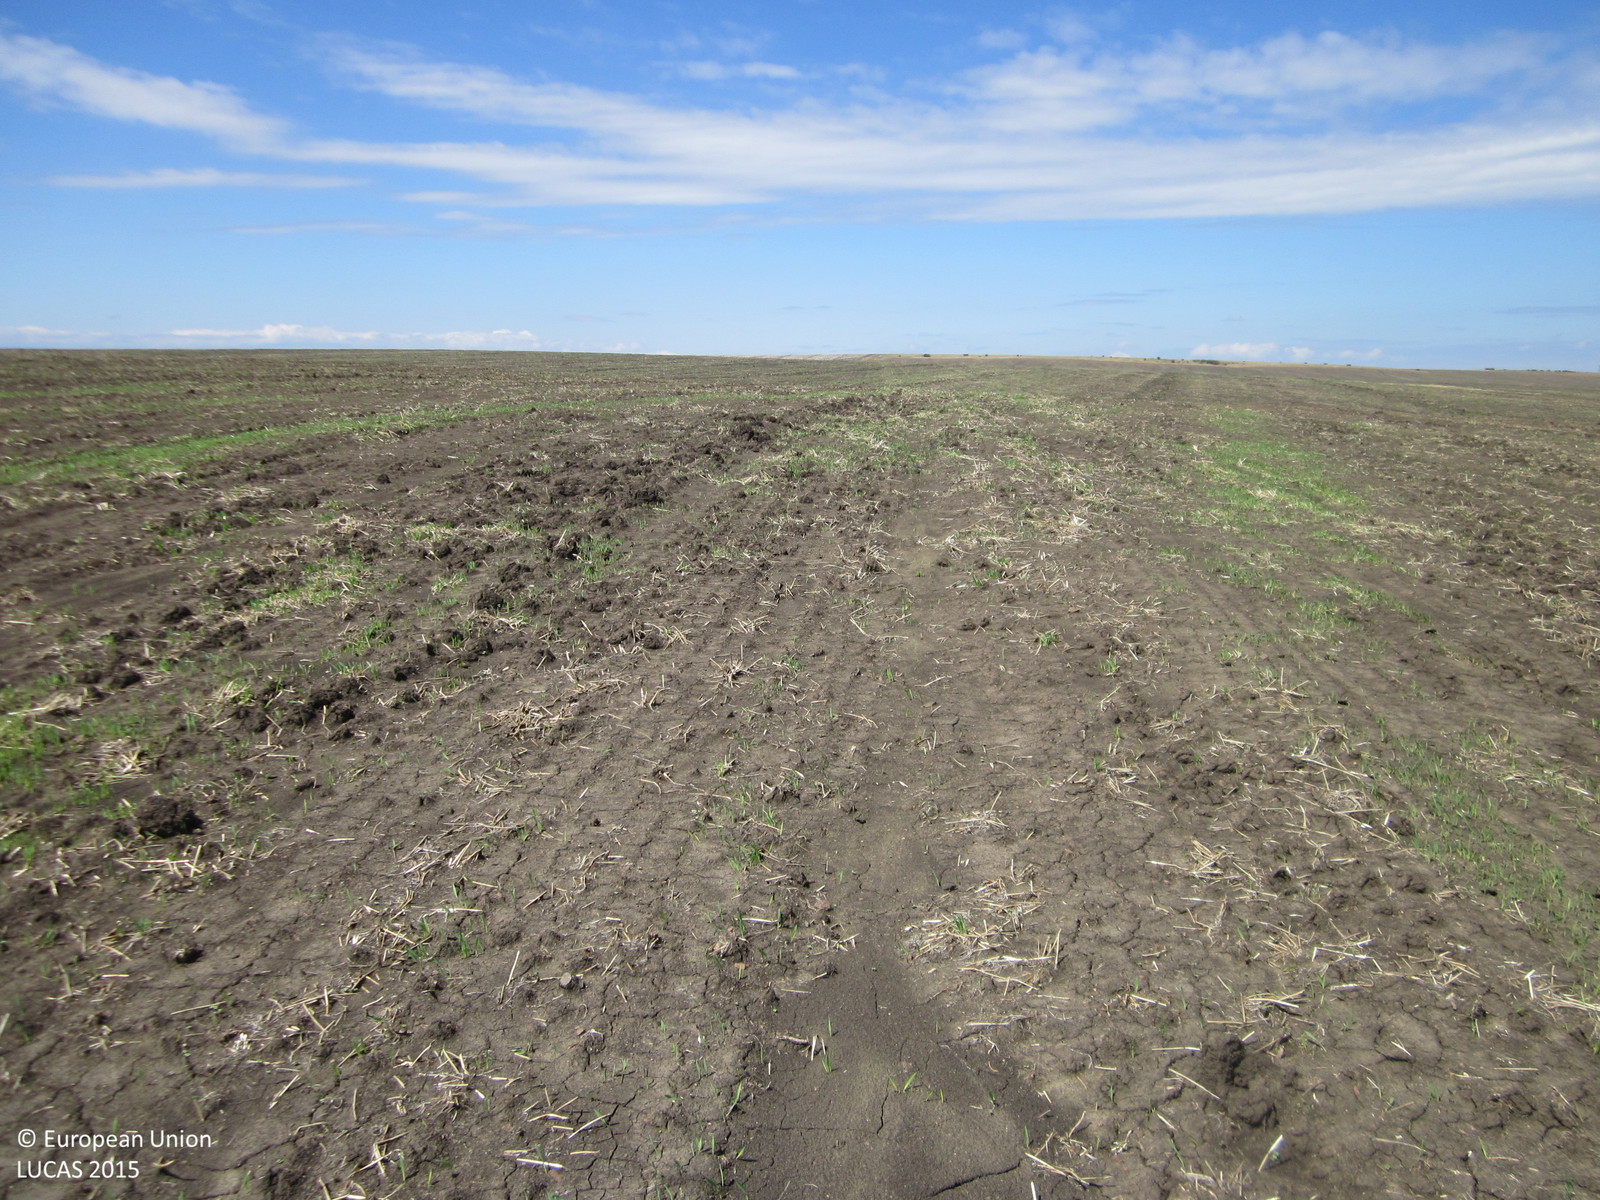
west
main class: Cropland
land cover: Common wheat
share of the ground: < 10 %
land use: Agriculture (excluding fallow land and kitchen gardens)
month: August
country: BG
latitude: 42.5925
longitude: 26.9587
